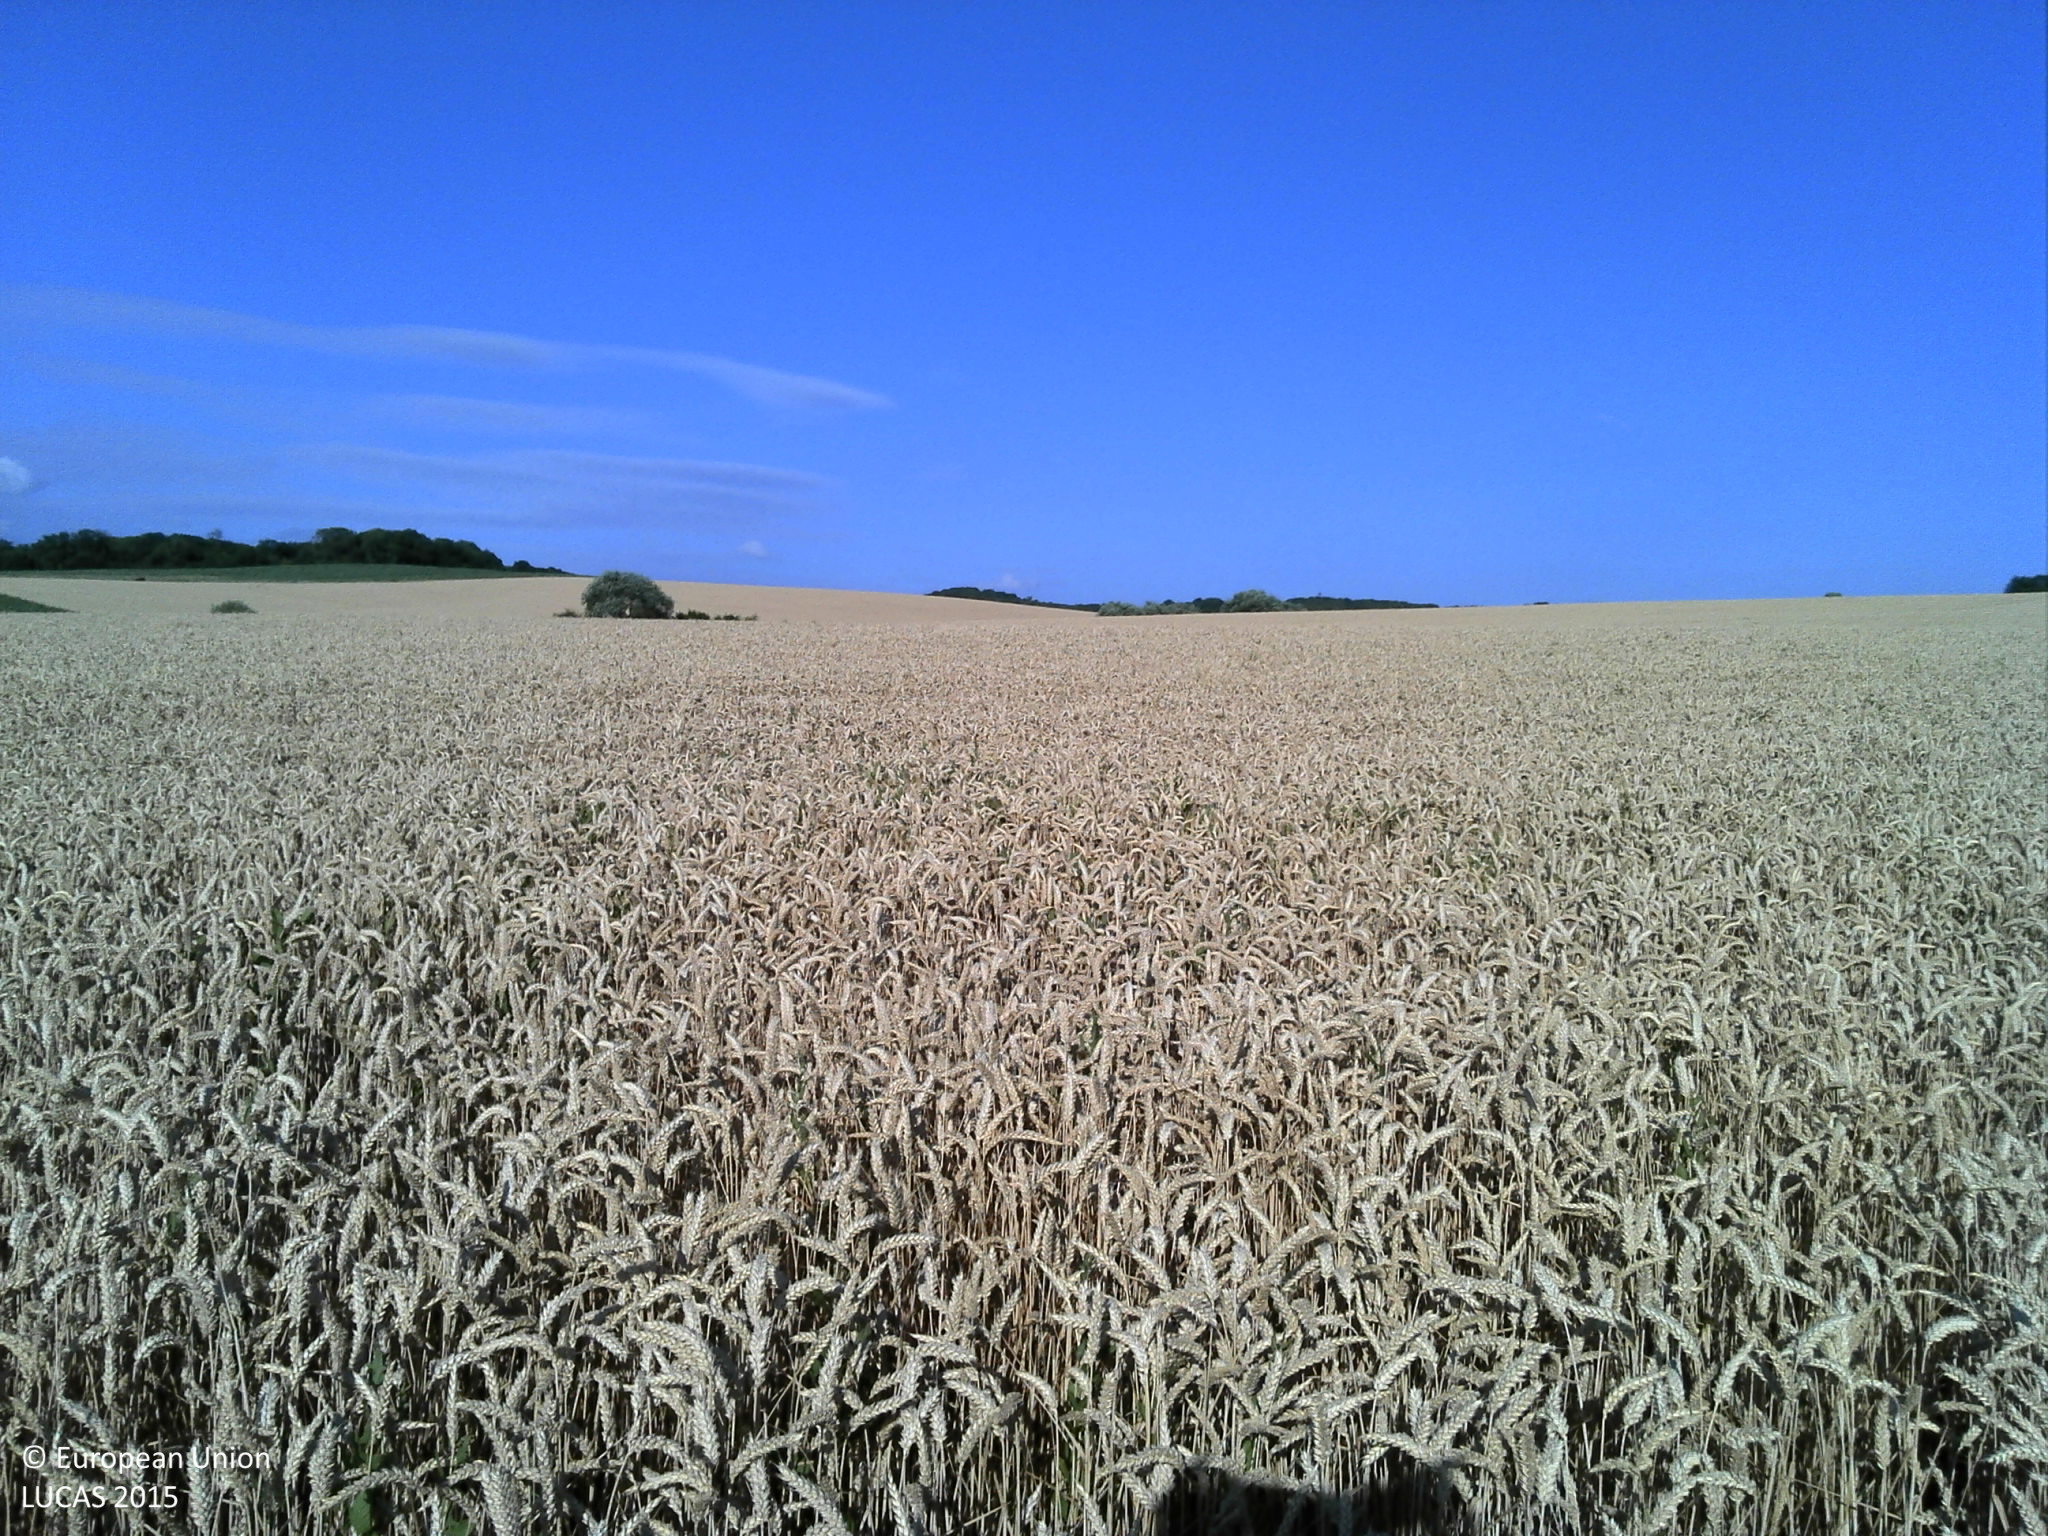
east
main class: Cropland
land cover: Common wheat
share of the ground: > 75 %
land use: Agriculture (excluding fallow land and kitchen gardens)
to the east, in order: Common wheat
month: July
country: FR
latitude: 49.2484
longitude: 6.4969
